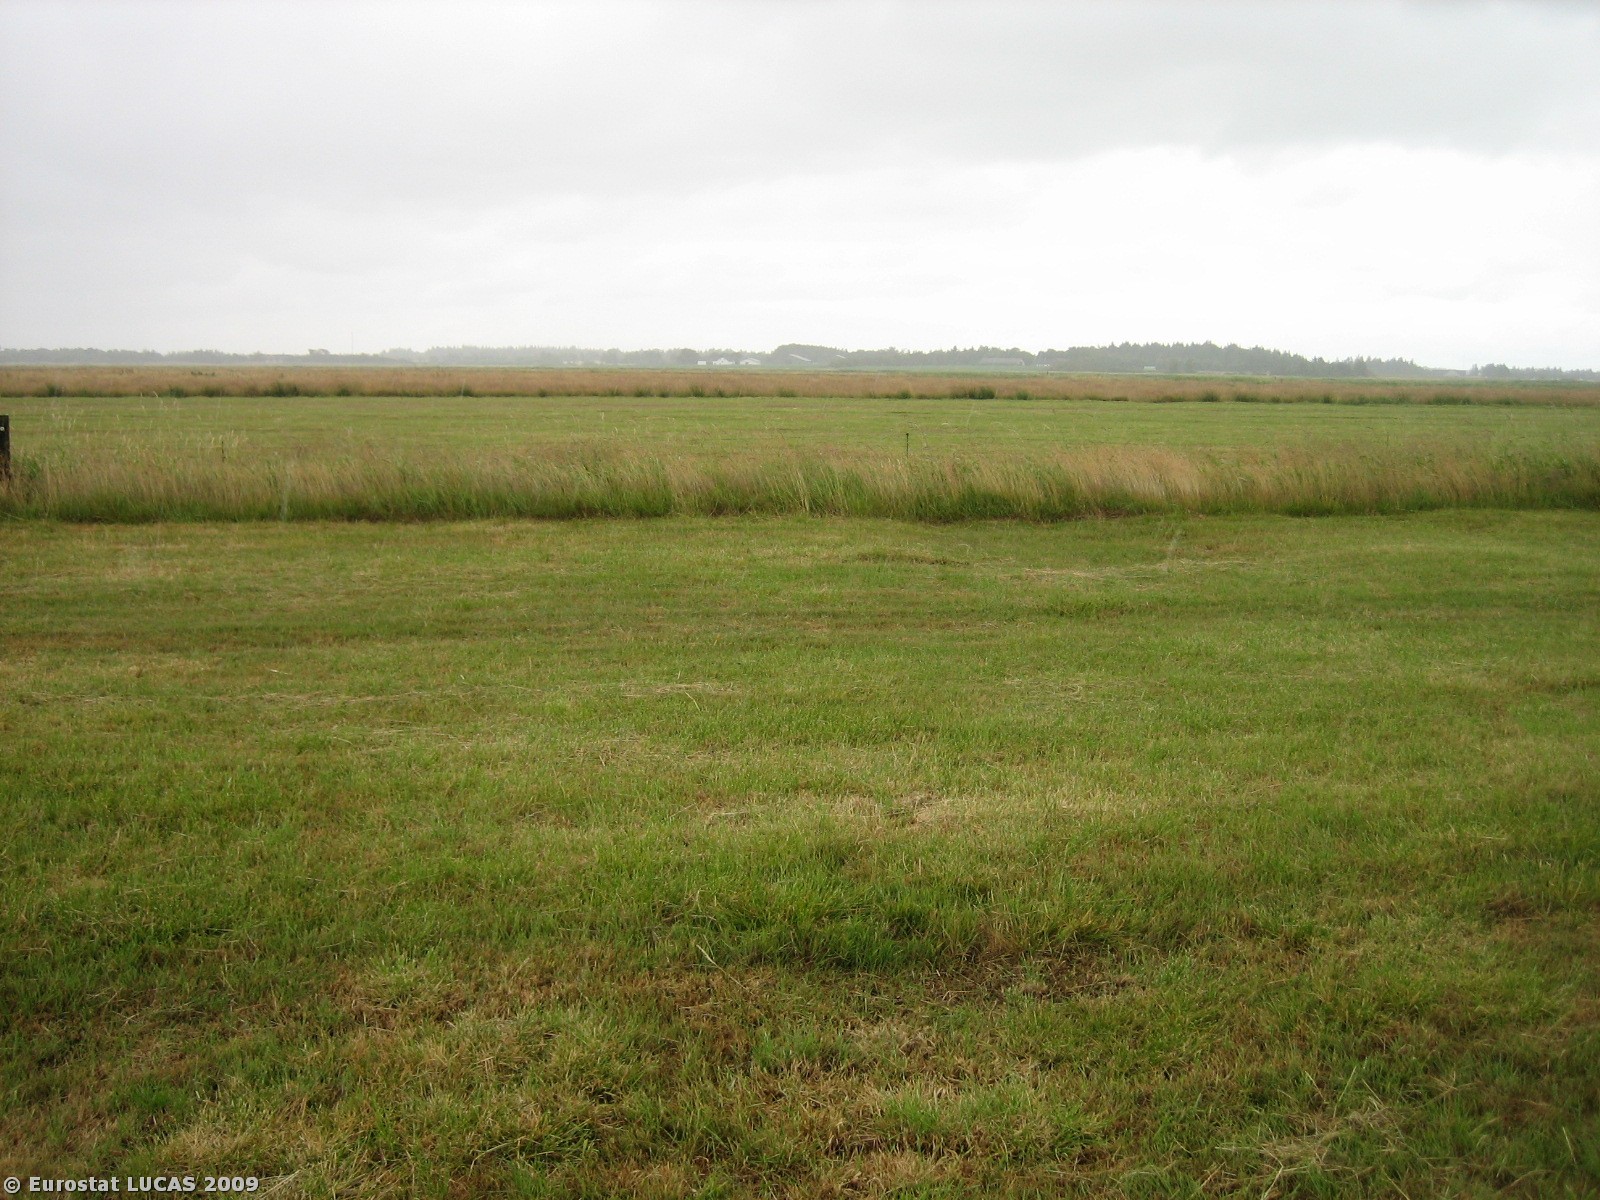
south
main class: Grassland
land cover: Grassland without tree/shrub cover
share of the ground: > 75 %
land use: Agriculture (excluding fallow land and kitchen gardens)
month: July
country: DK
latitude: 55.6020
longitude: 8.3667
